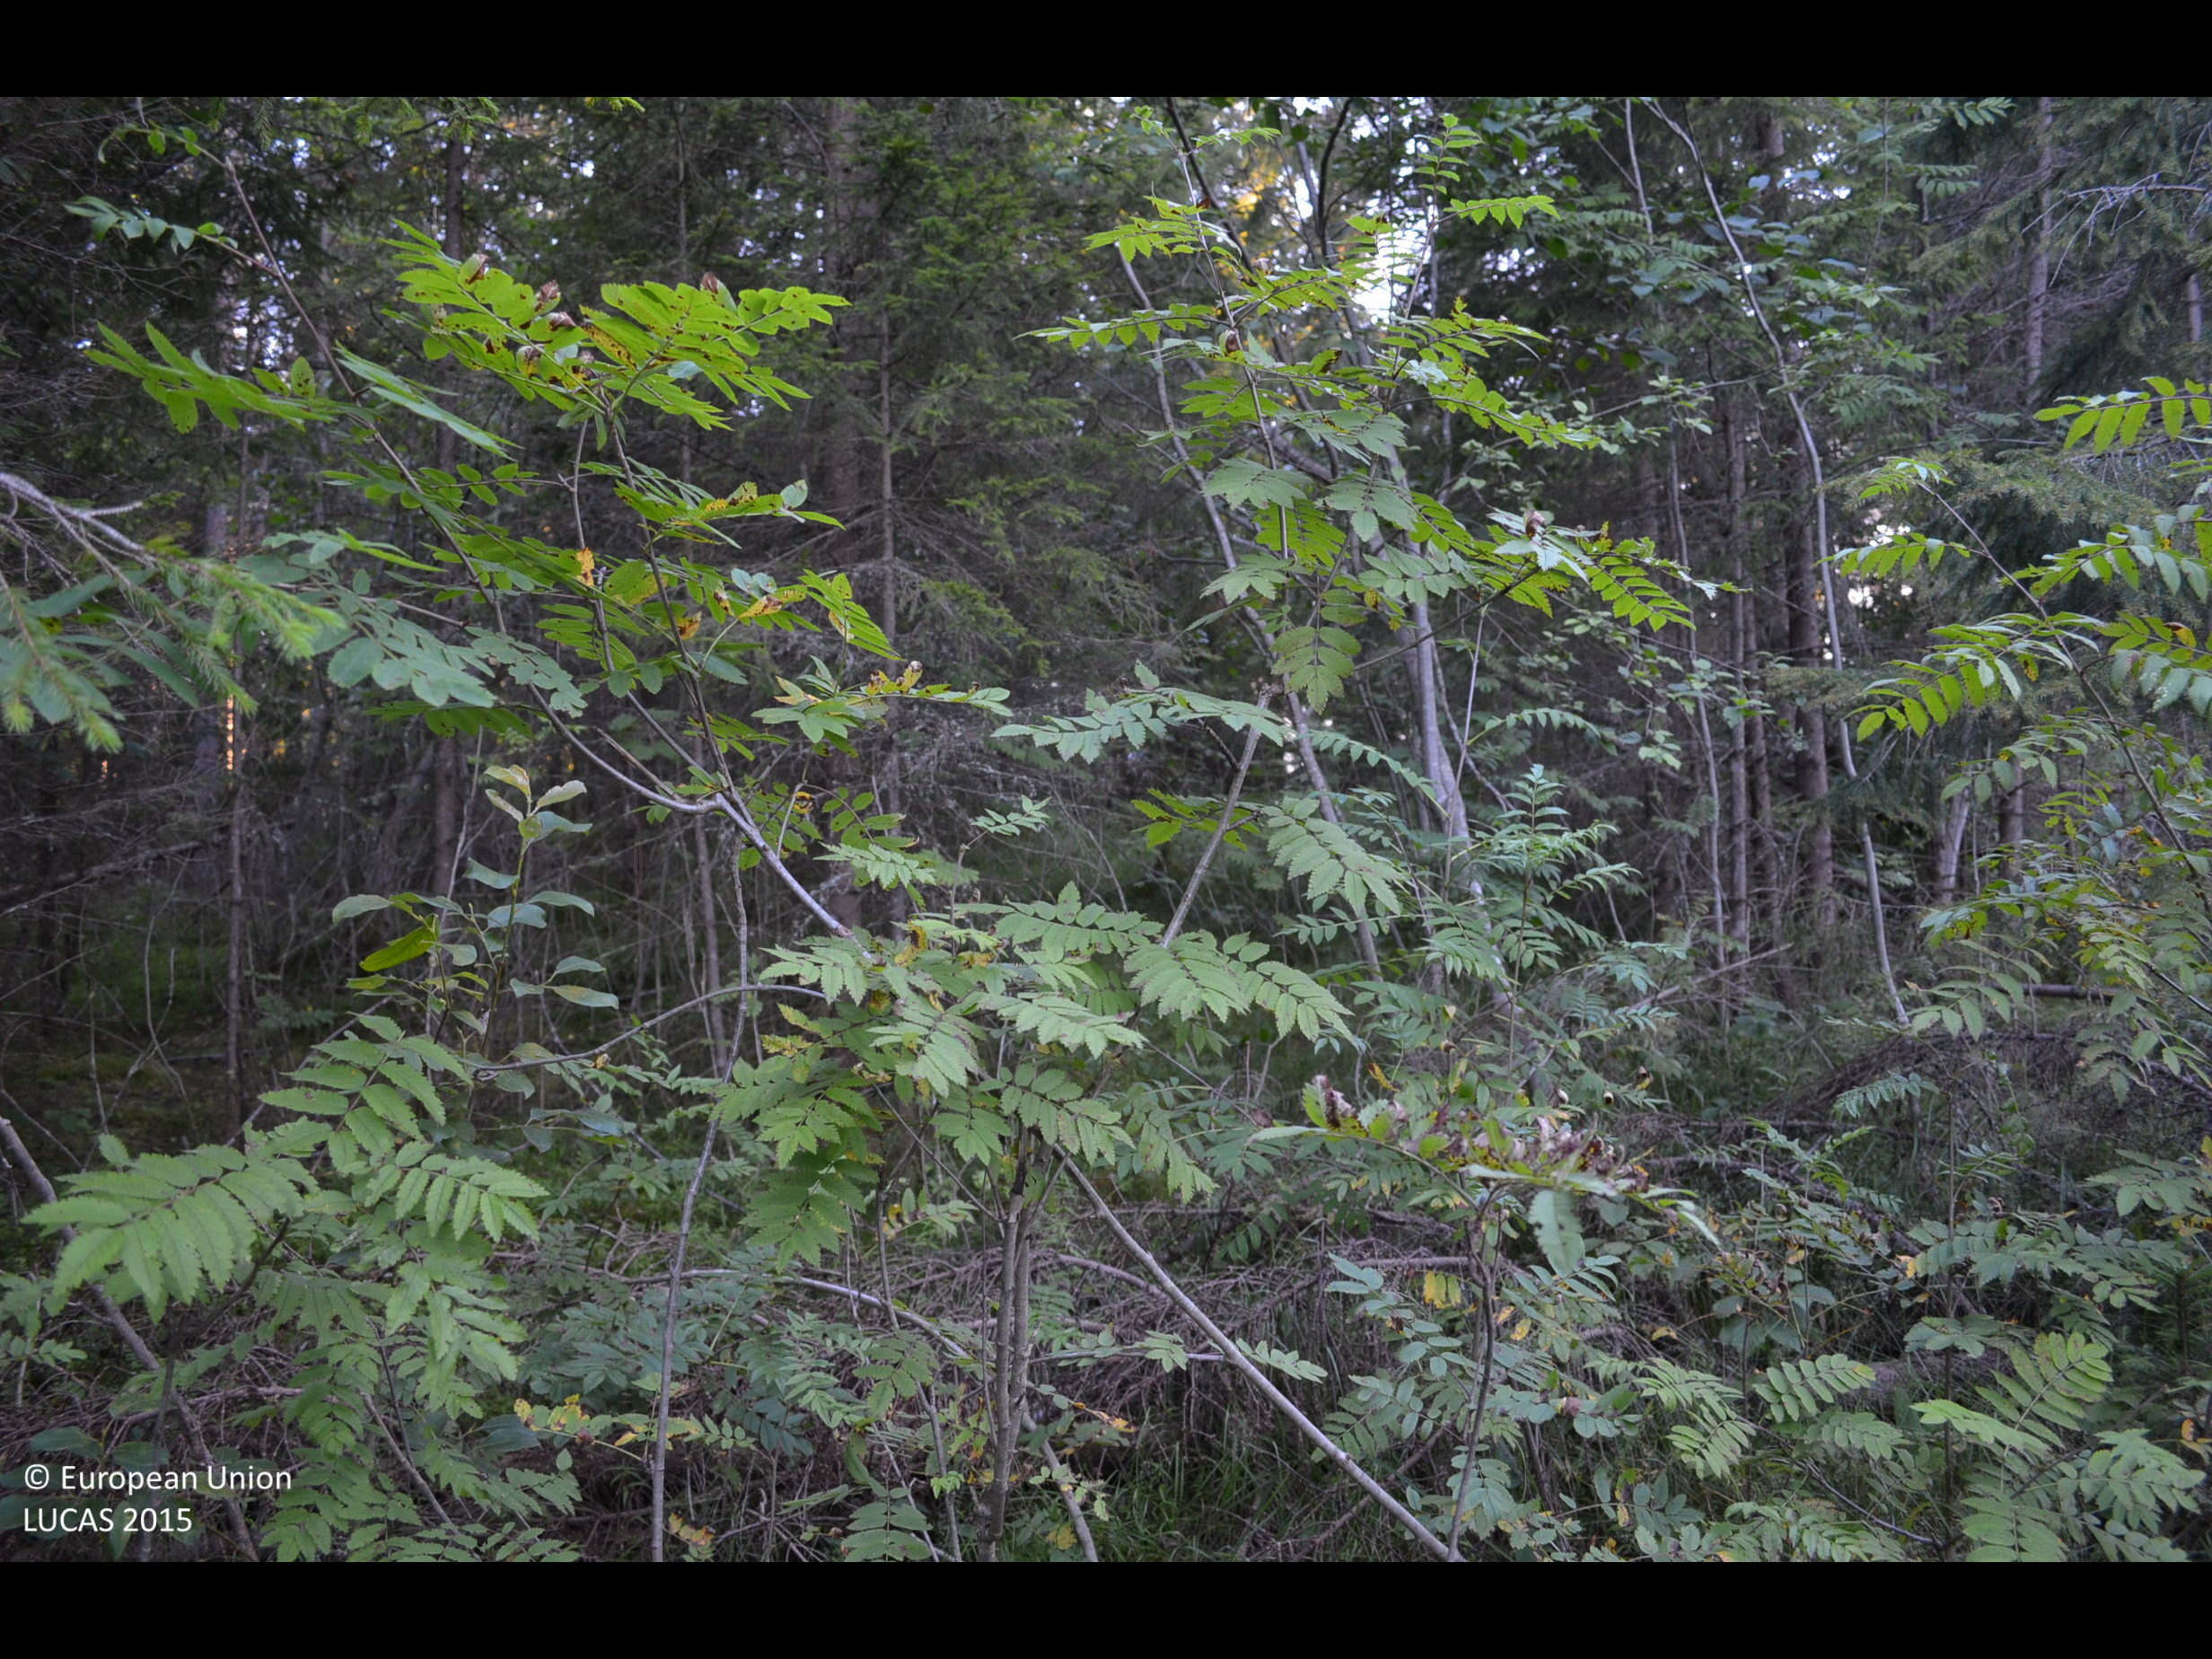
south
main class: Woodland
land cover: Other coniferous woodland
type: boreal forest
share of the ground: > 75 %
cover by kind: coniferous forest trees 70 %, shrubs 15 %, lichens and mosses 10 %, broadleaved forest trees 5 %
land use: Forestry
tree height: > 5 m
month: August
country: FI
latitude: 62.3808
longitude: 24.3378
